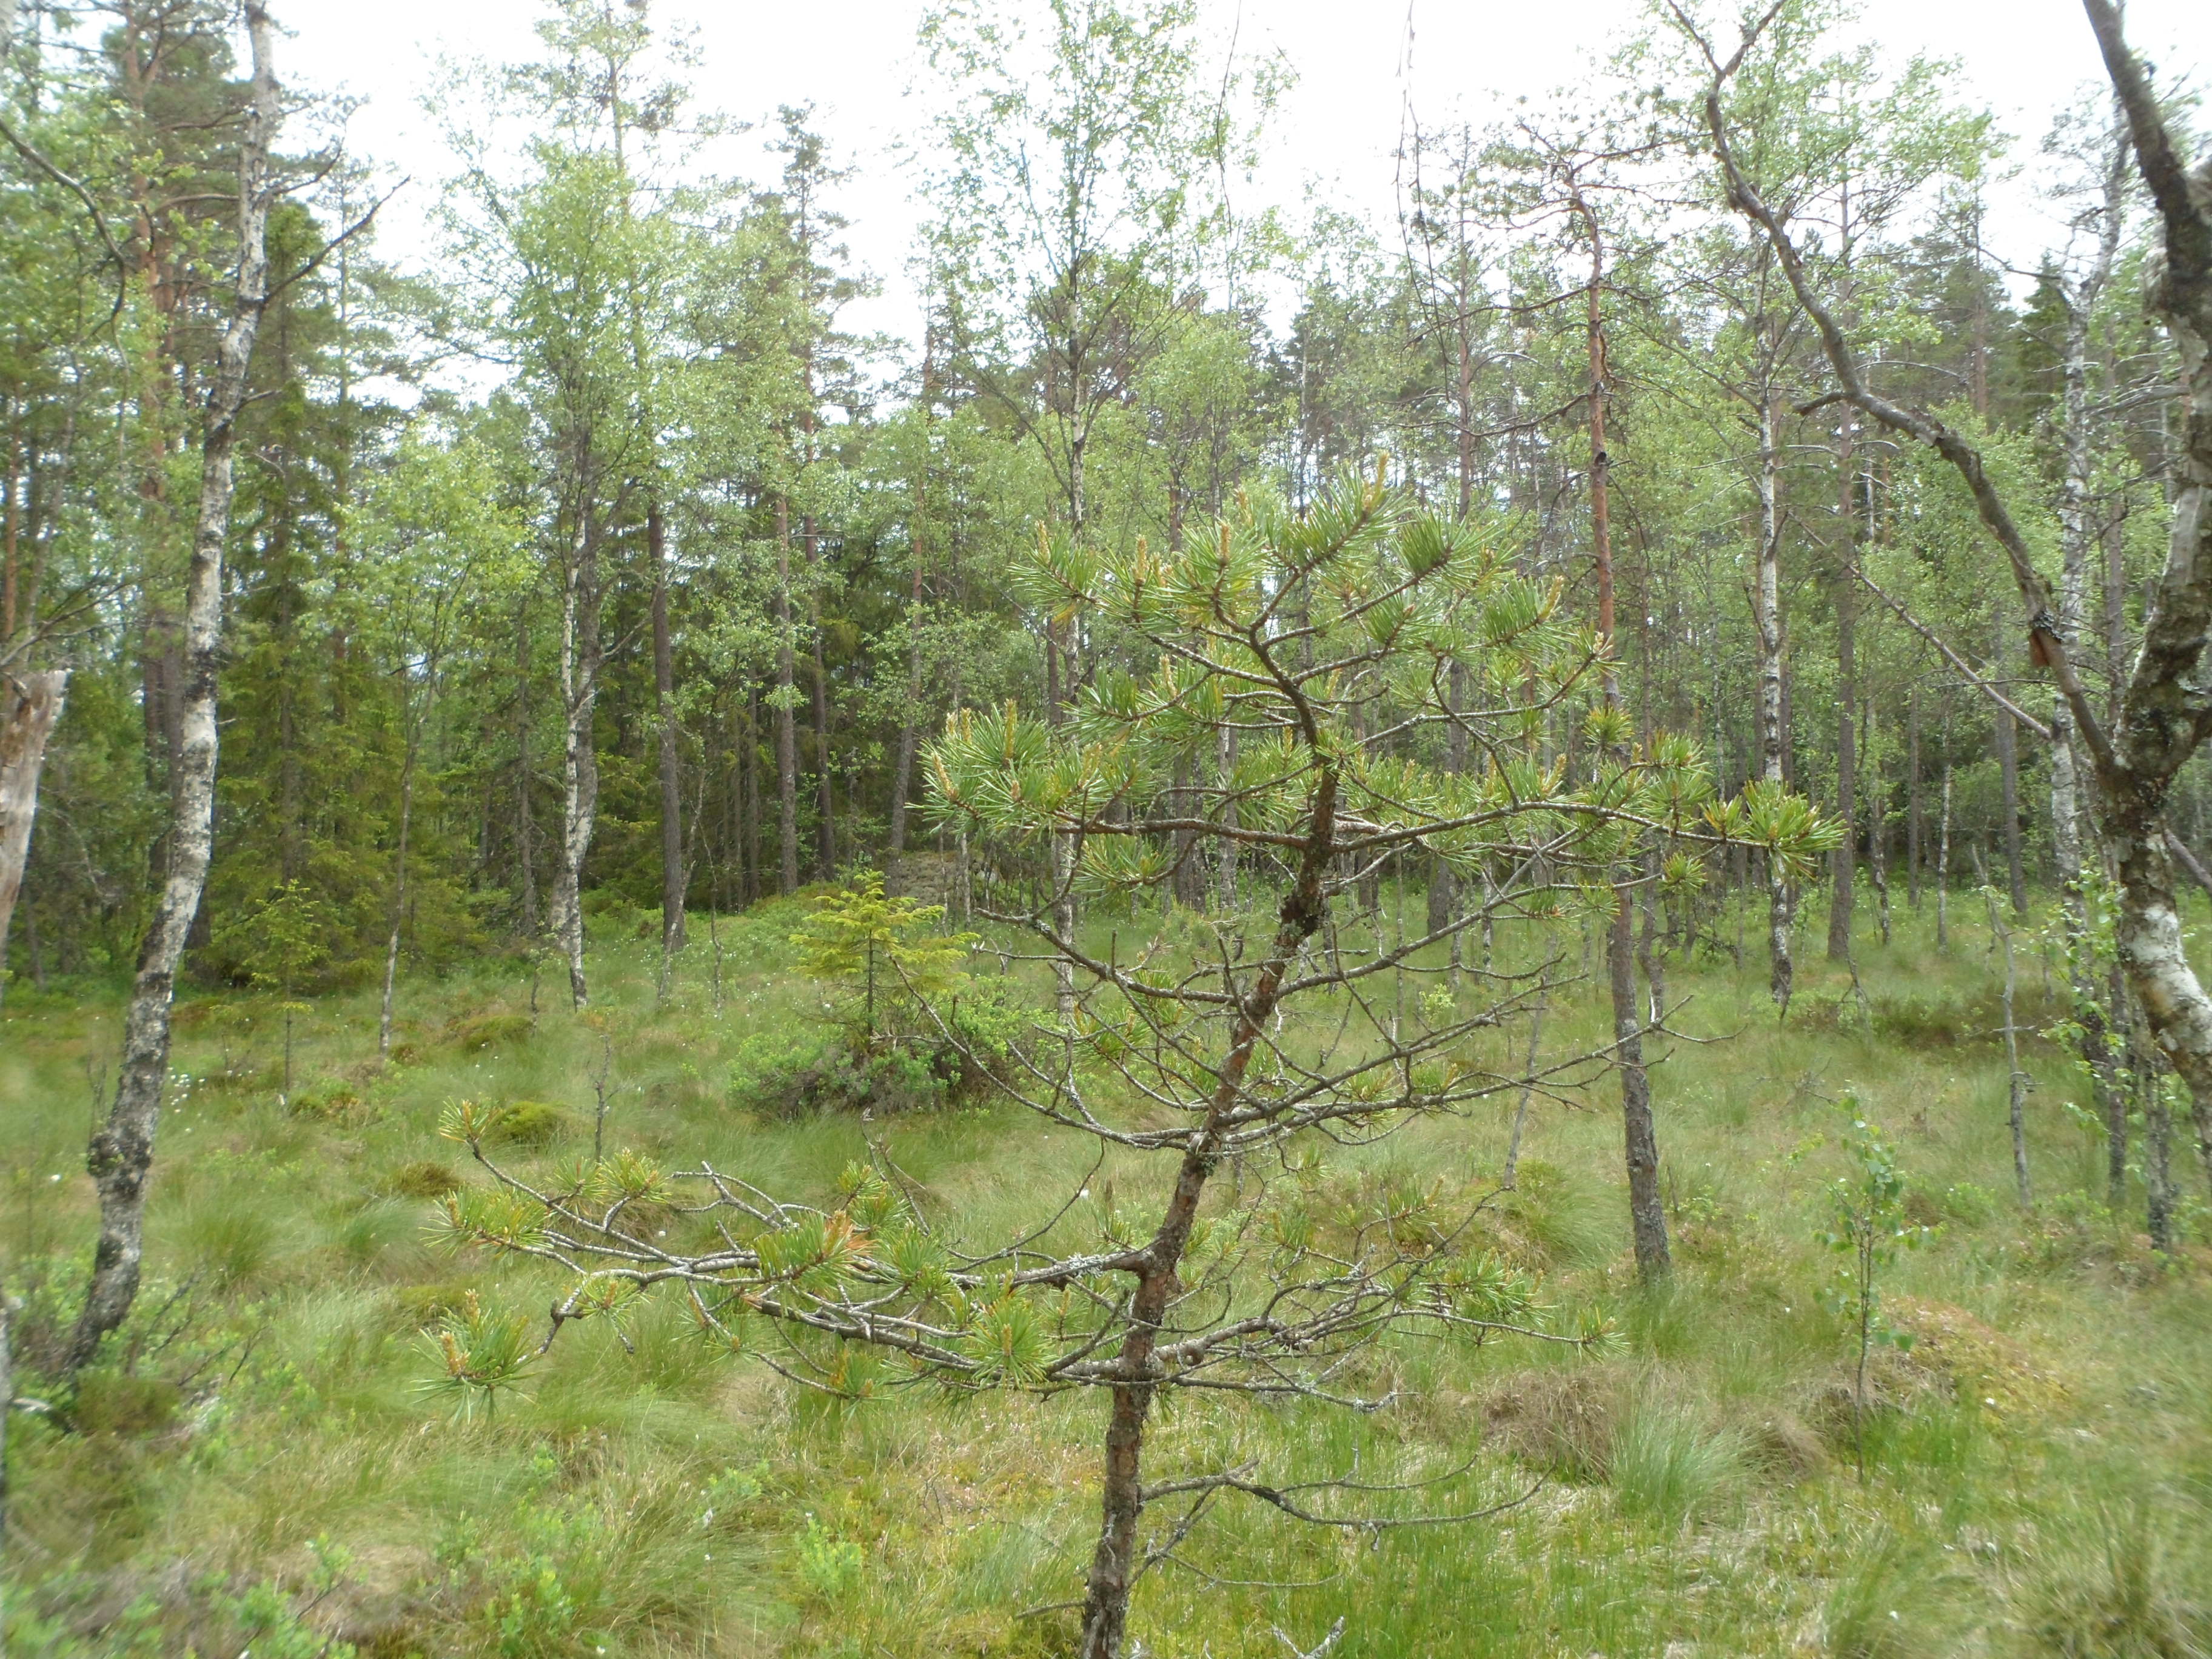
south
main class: Woodland
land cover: Pine dominated mixed woodland
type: boreal forest
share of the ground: 10 - 25 %
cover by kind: herbaceous plants 55 %, coniferous forest trees 15 %, lichens and mosses 15 %, broadleaved forest trees 10 %, shrubs 5 %
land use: Forestry
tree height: > 5 m
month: June
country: SE
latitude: 57.4099
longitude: 14.3737
